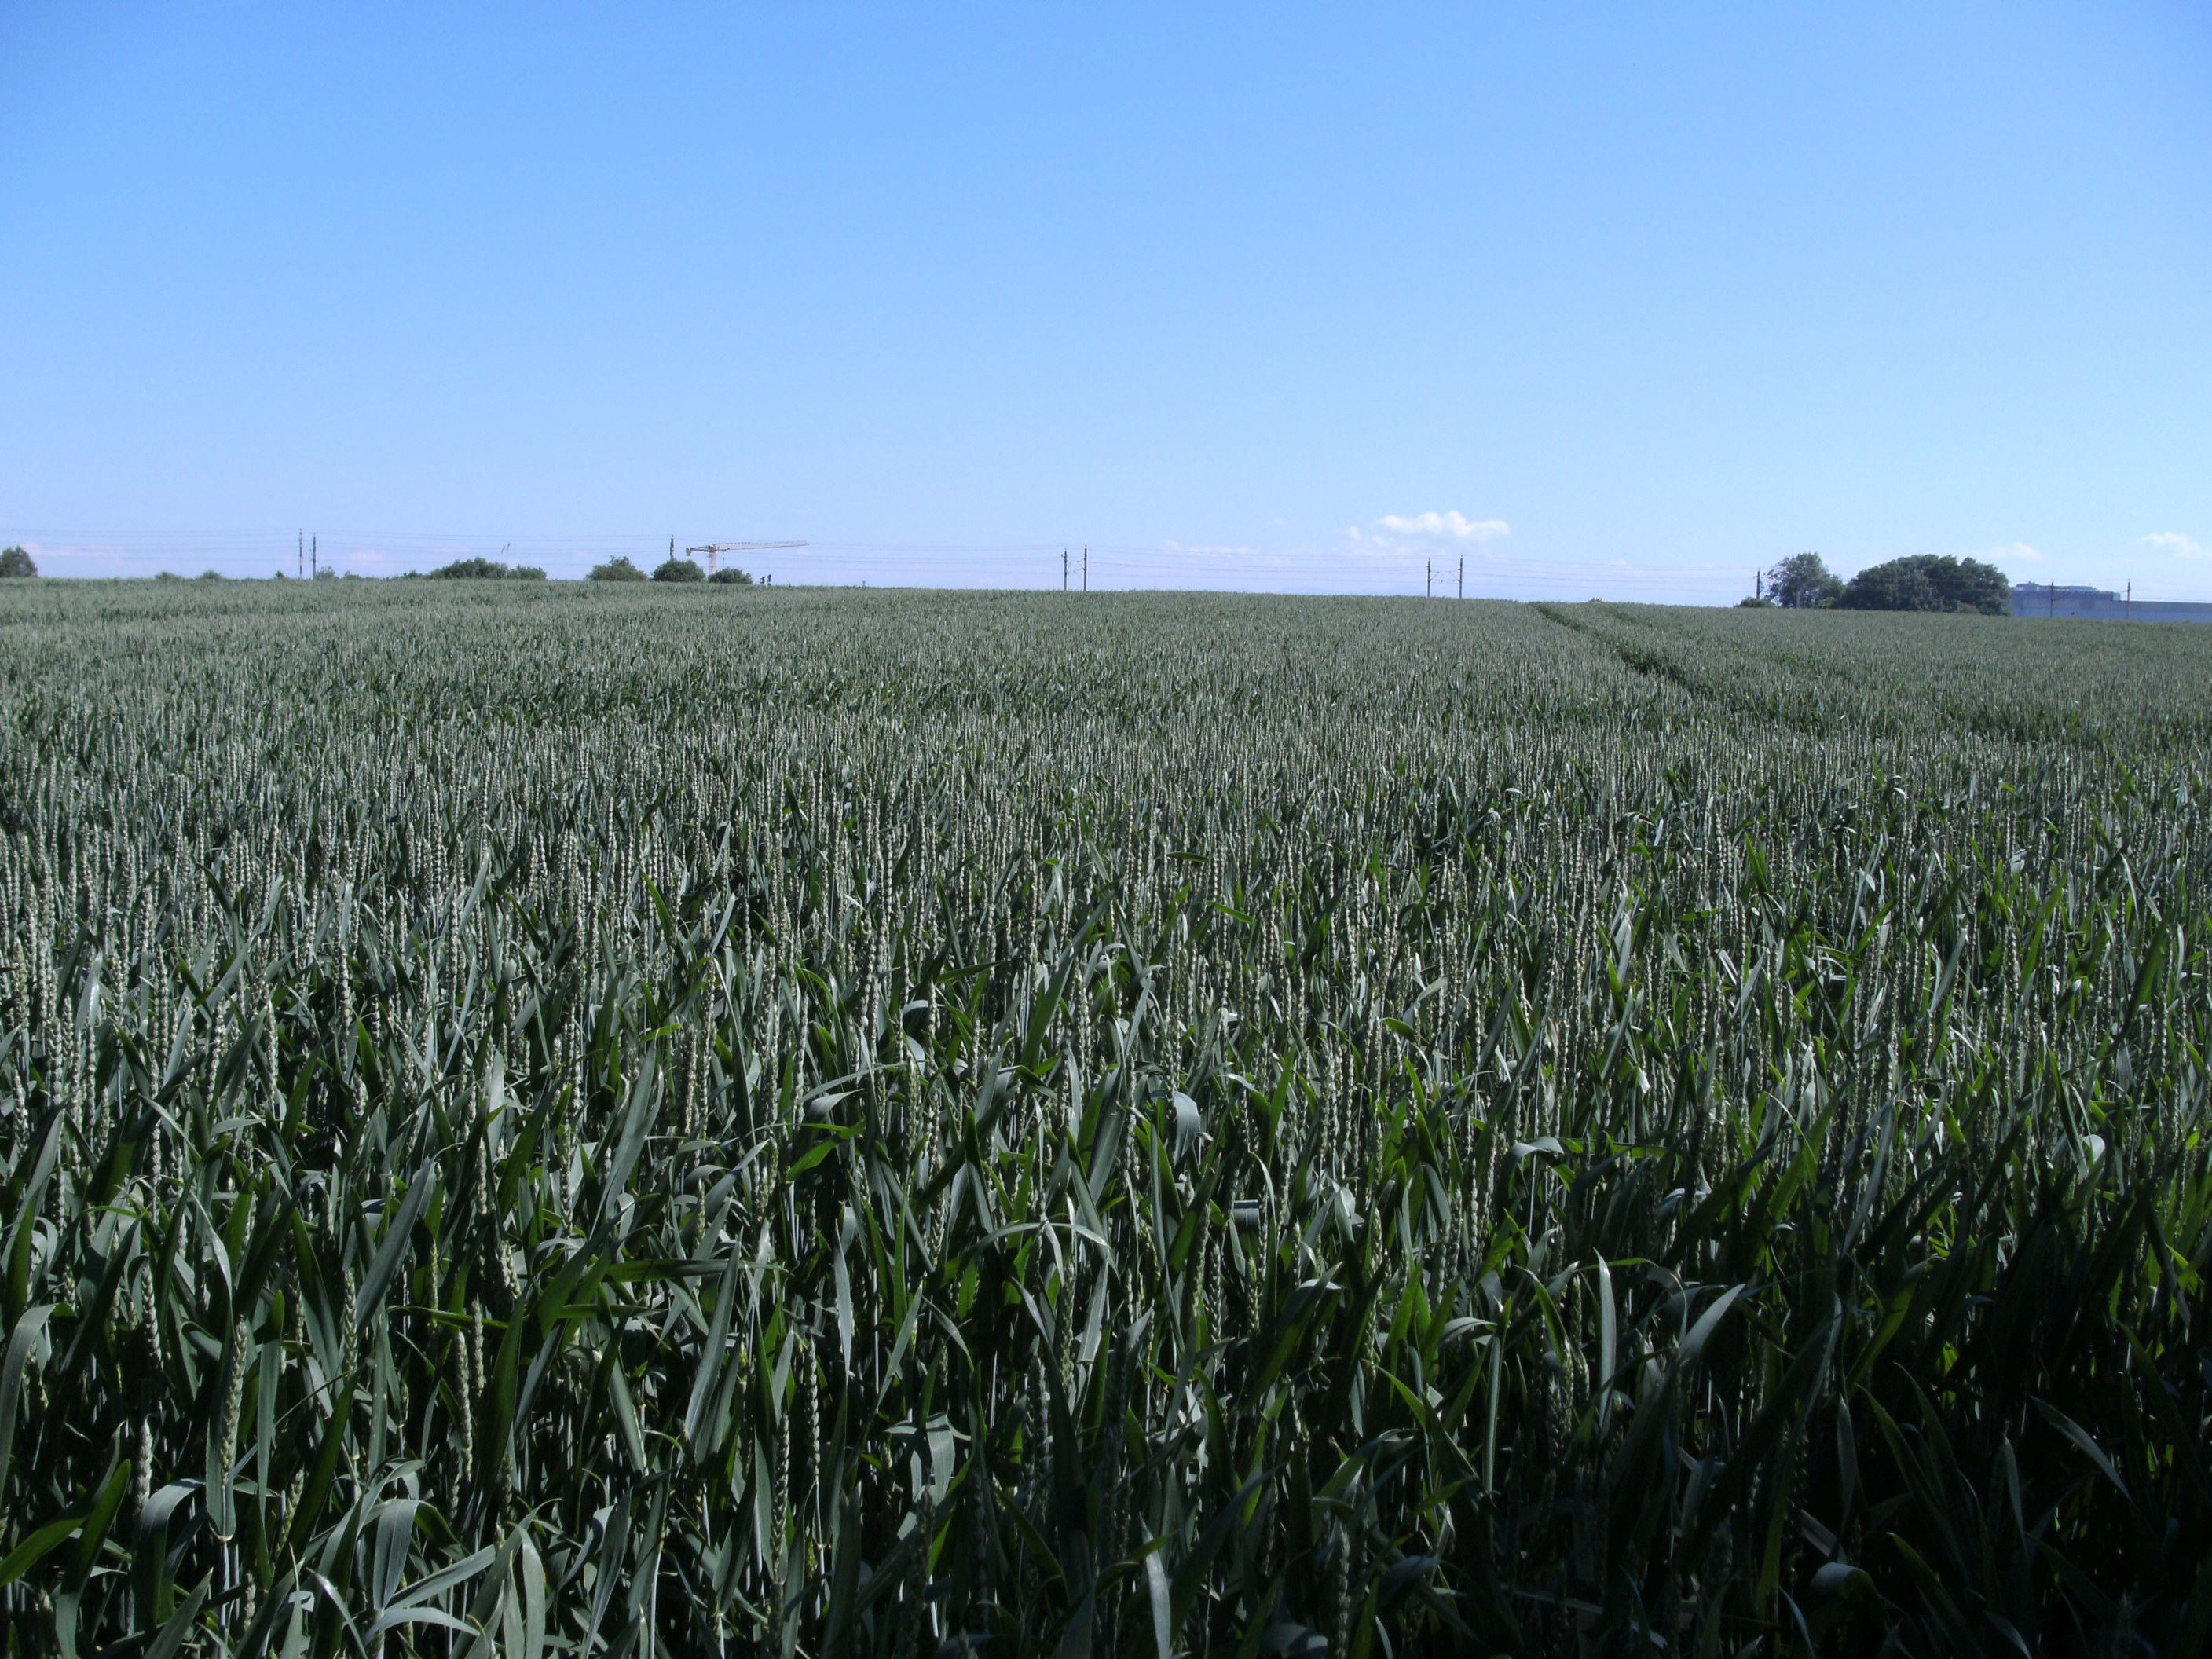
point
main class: Cropland
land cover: Common wheat
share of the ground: > 75 %
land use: Agriculture (excluding fallow land and kitchen gardens)
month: June
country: AT
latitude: 48.2352
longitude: 14.1602
